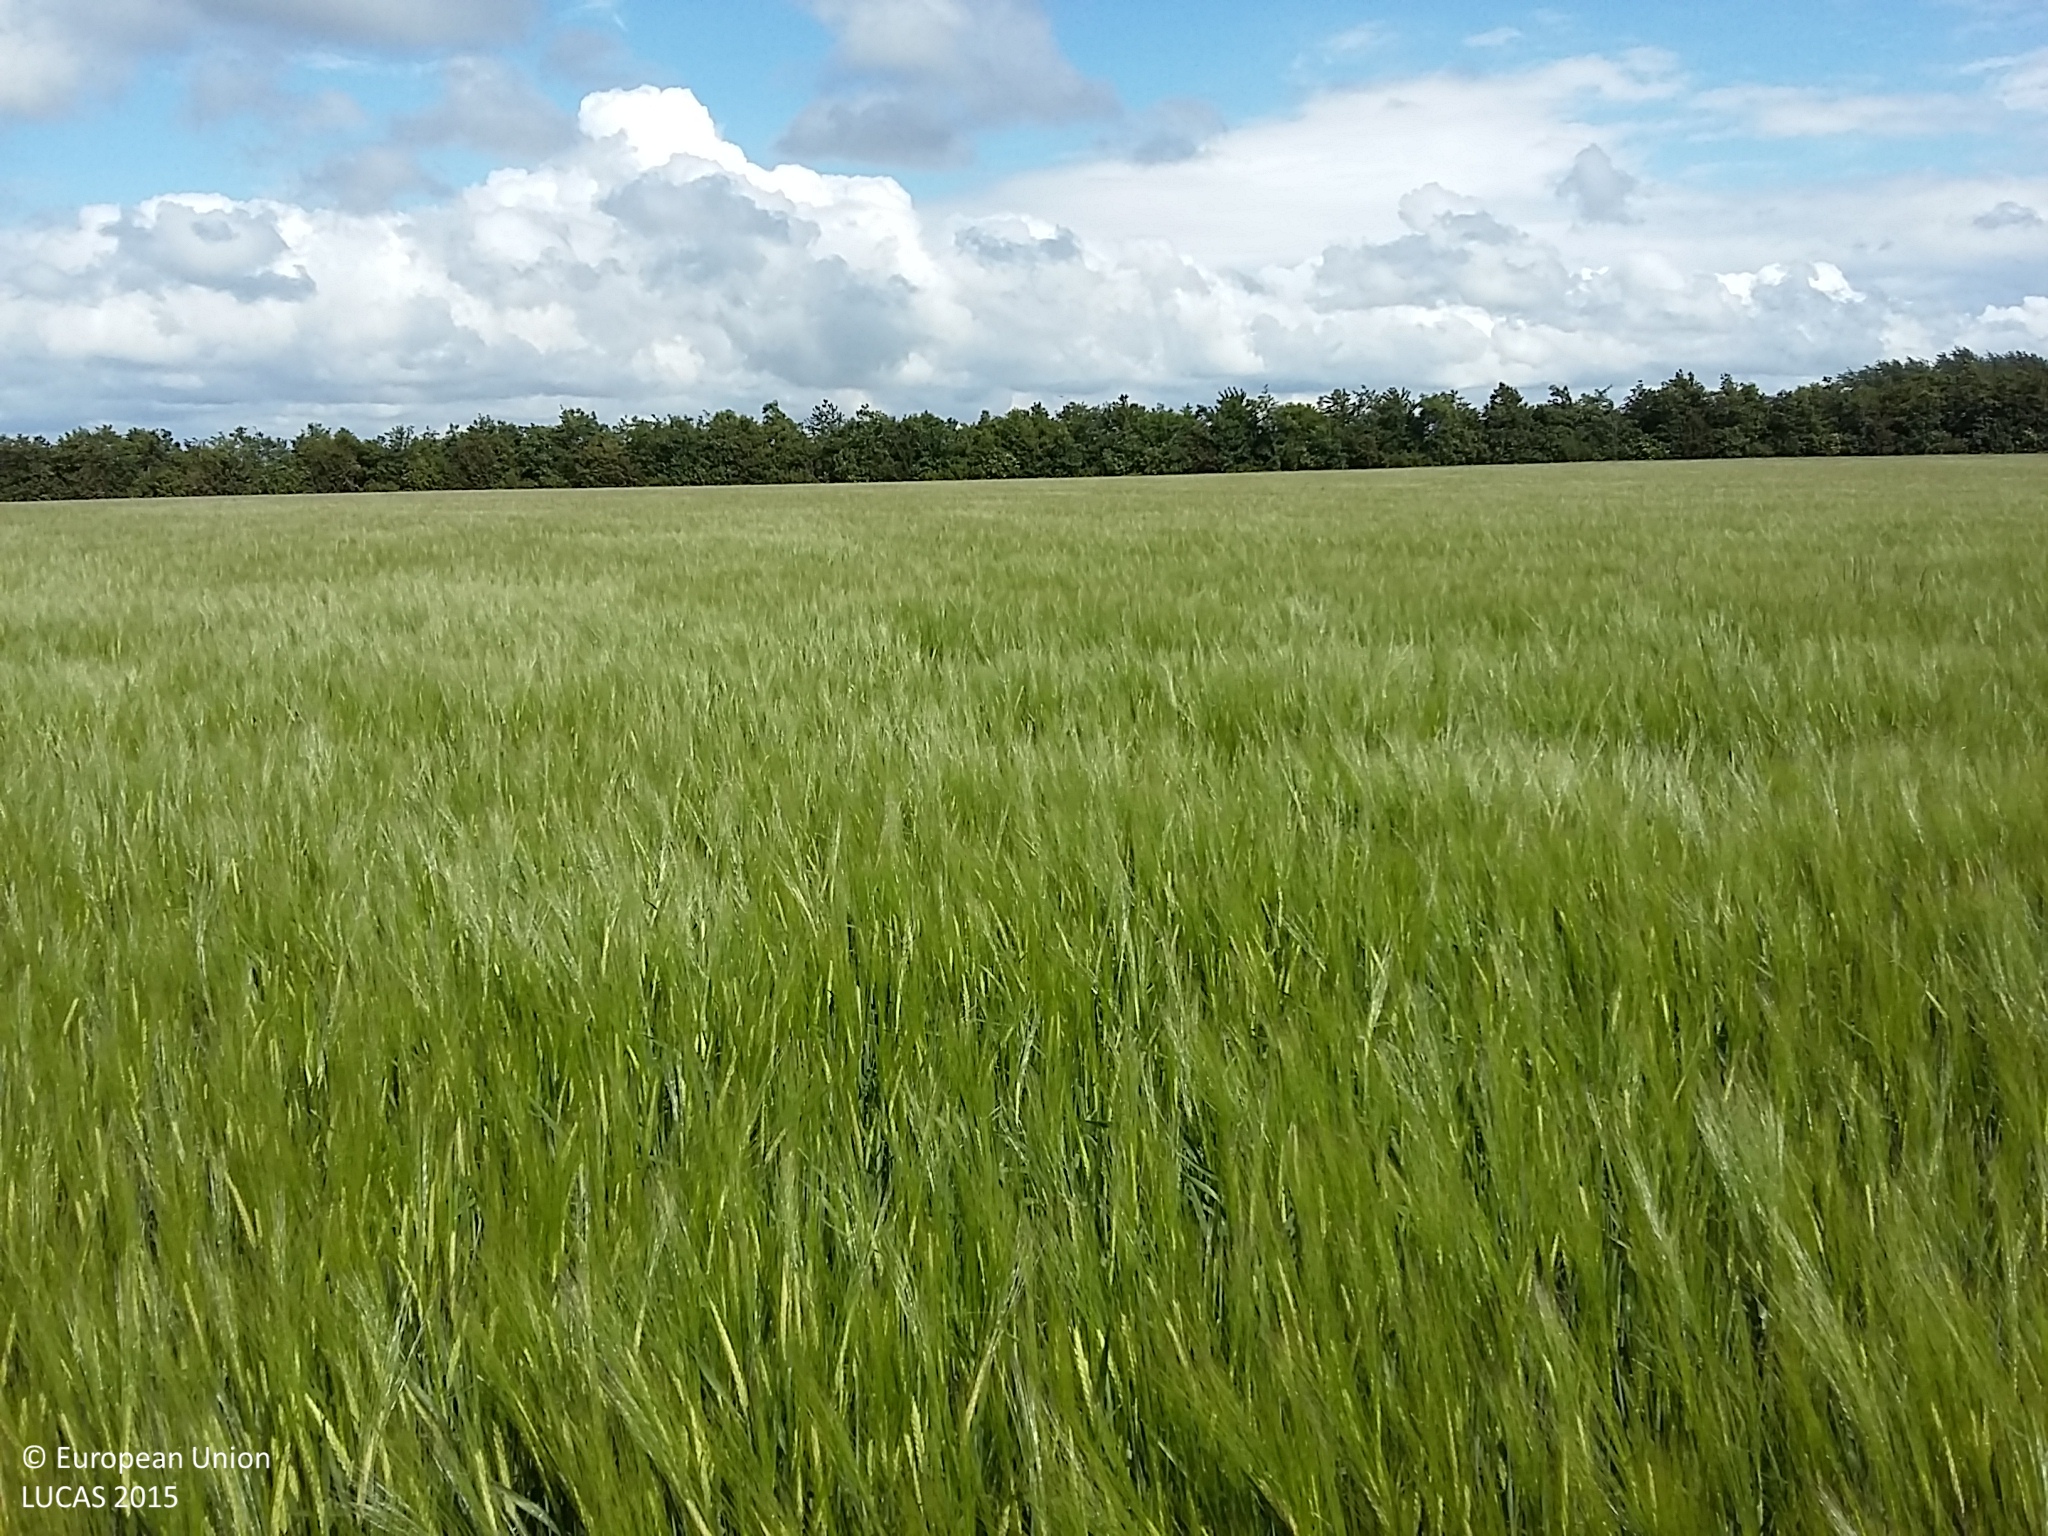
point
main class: Cropland
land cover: Barley
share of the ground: > 75 %
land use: Agriculture (excluding fallow land and kitchen gardens)
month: June
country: DK
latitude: 54.7258
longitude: 11.2258
